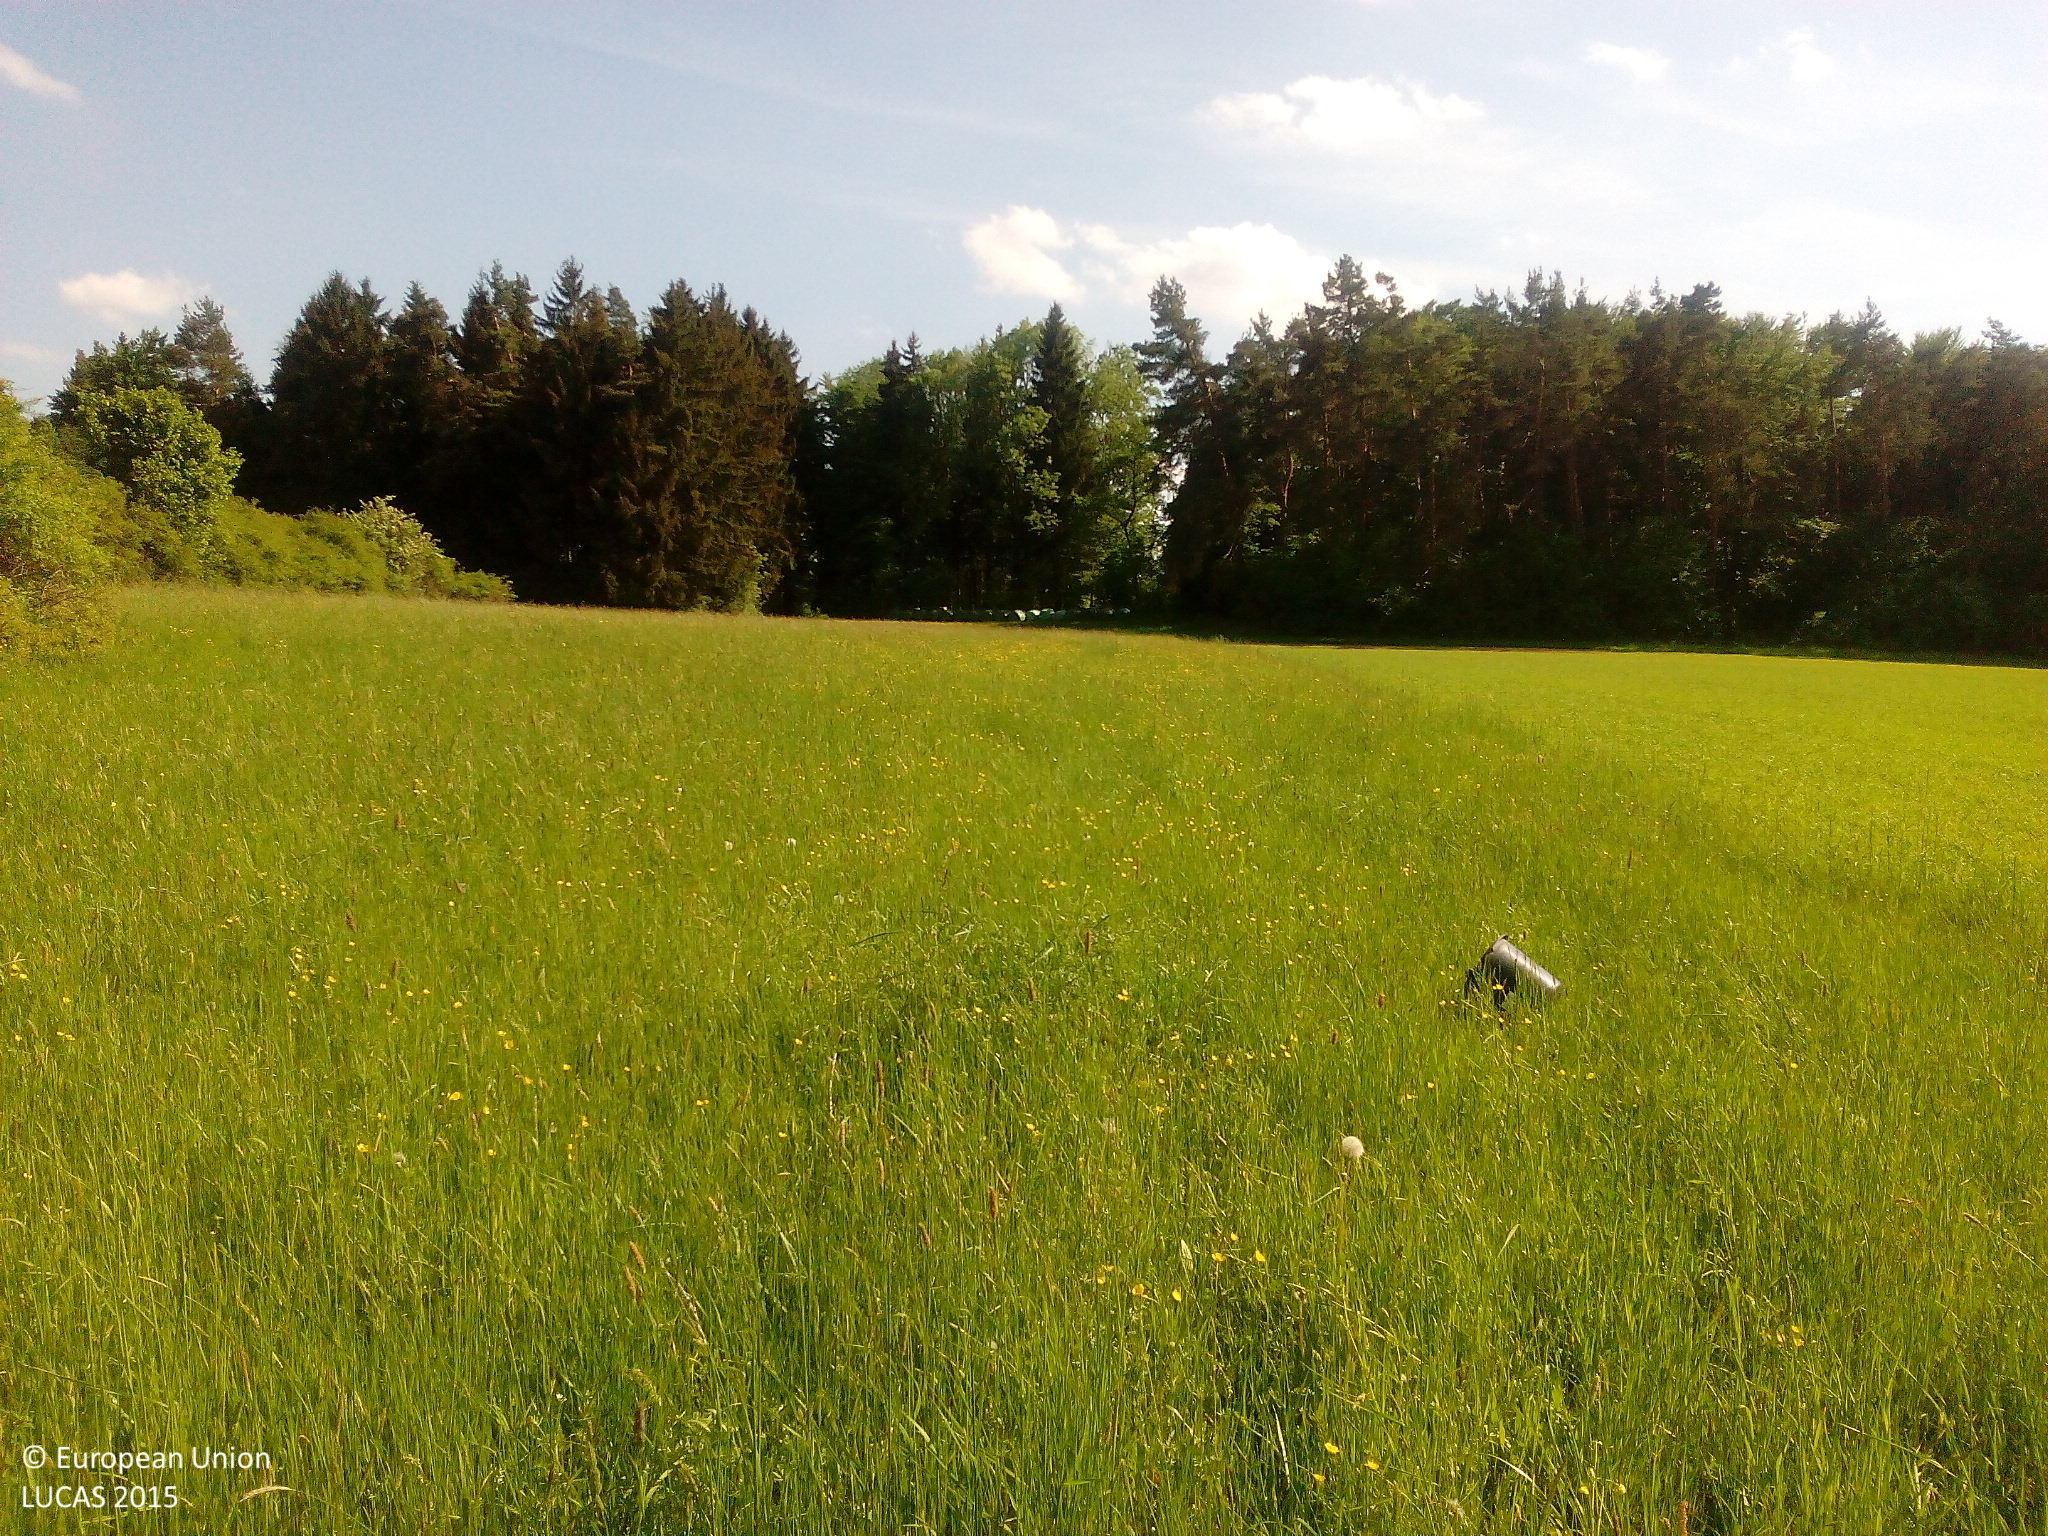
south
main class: Grassland
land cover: Grassland without tree/shrub cover
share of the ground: > 75 %
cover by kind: herbaceous plants 100 %
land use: Agriculture (excluding fallow land and kitchen gardens)
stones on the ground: < 10 %
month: May
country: DE
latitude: 49.4372
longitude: 11.4751
